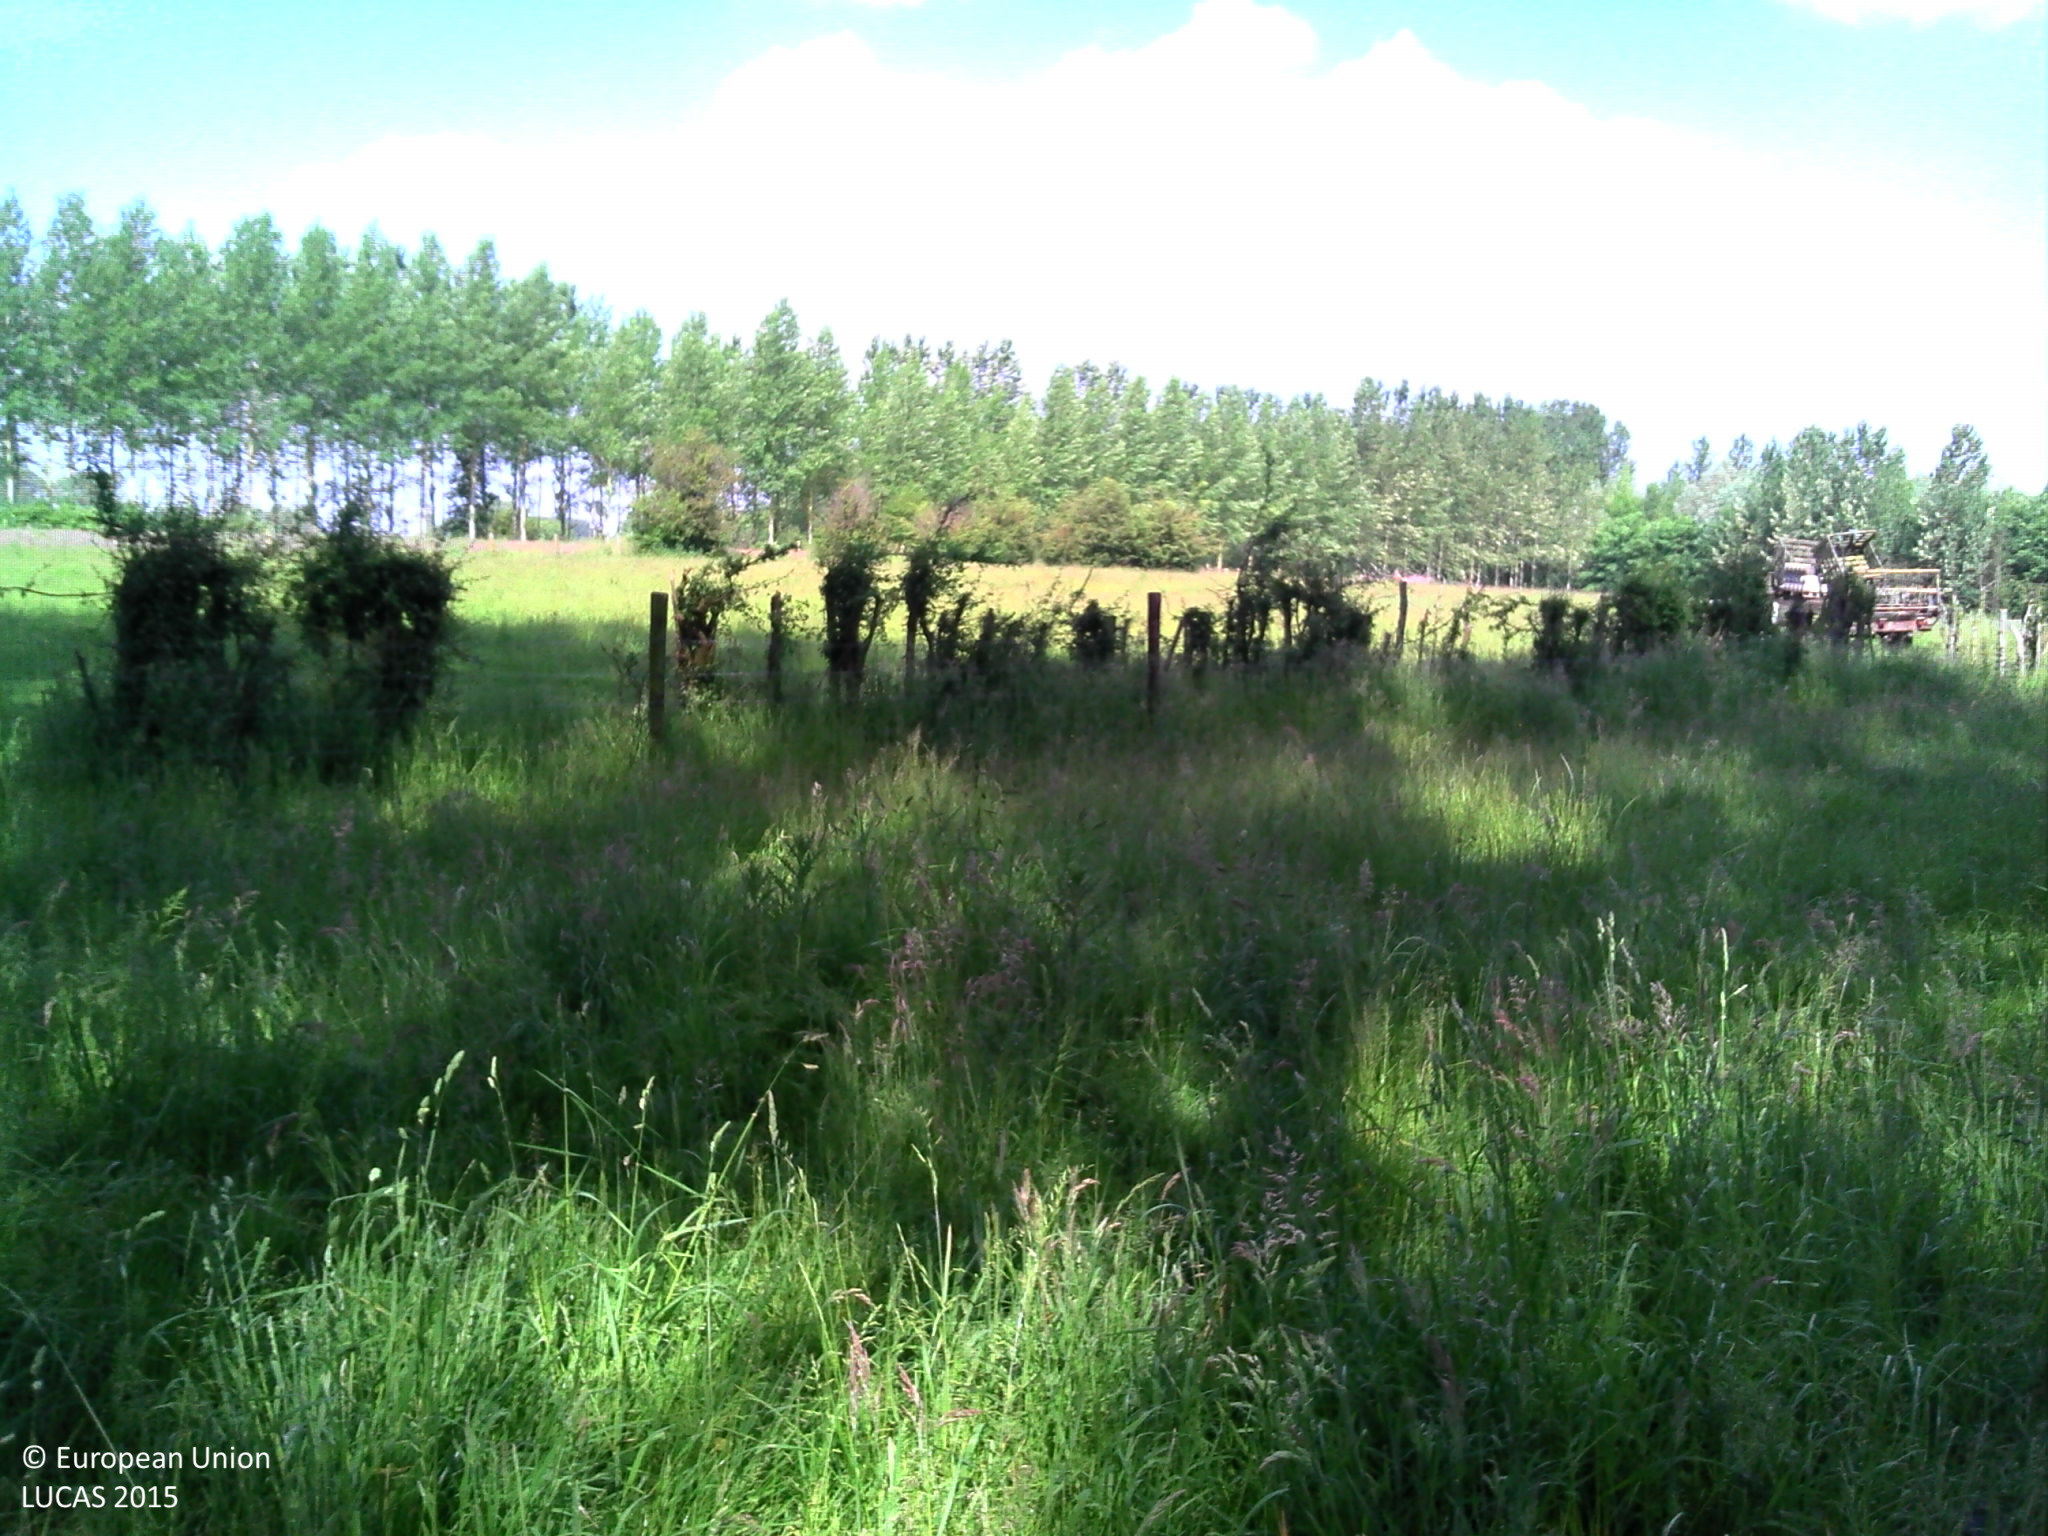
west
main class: Grassland
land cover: Grassland without tree/shrub cover
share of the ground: > 75 %
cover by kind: herbaceous plants 100 %
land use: Agriculture (excluding fallow land and kitchen gardens)
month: June
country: BE
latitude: 50.9236
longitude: 3.9192
